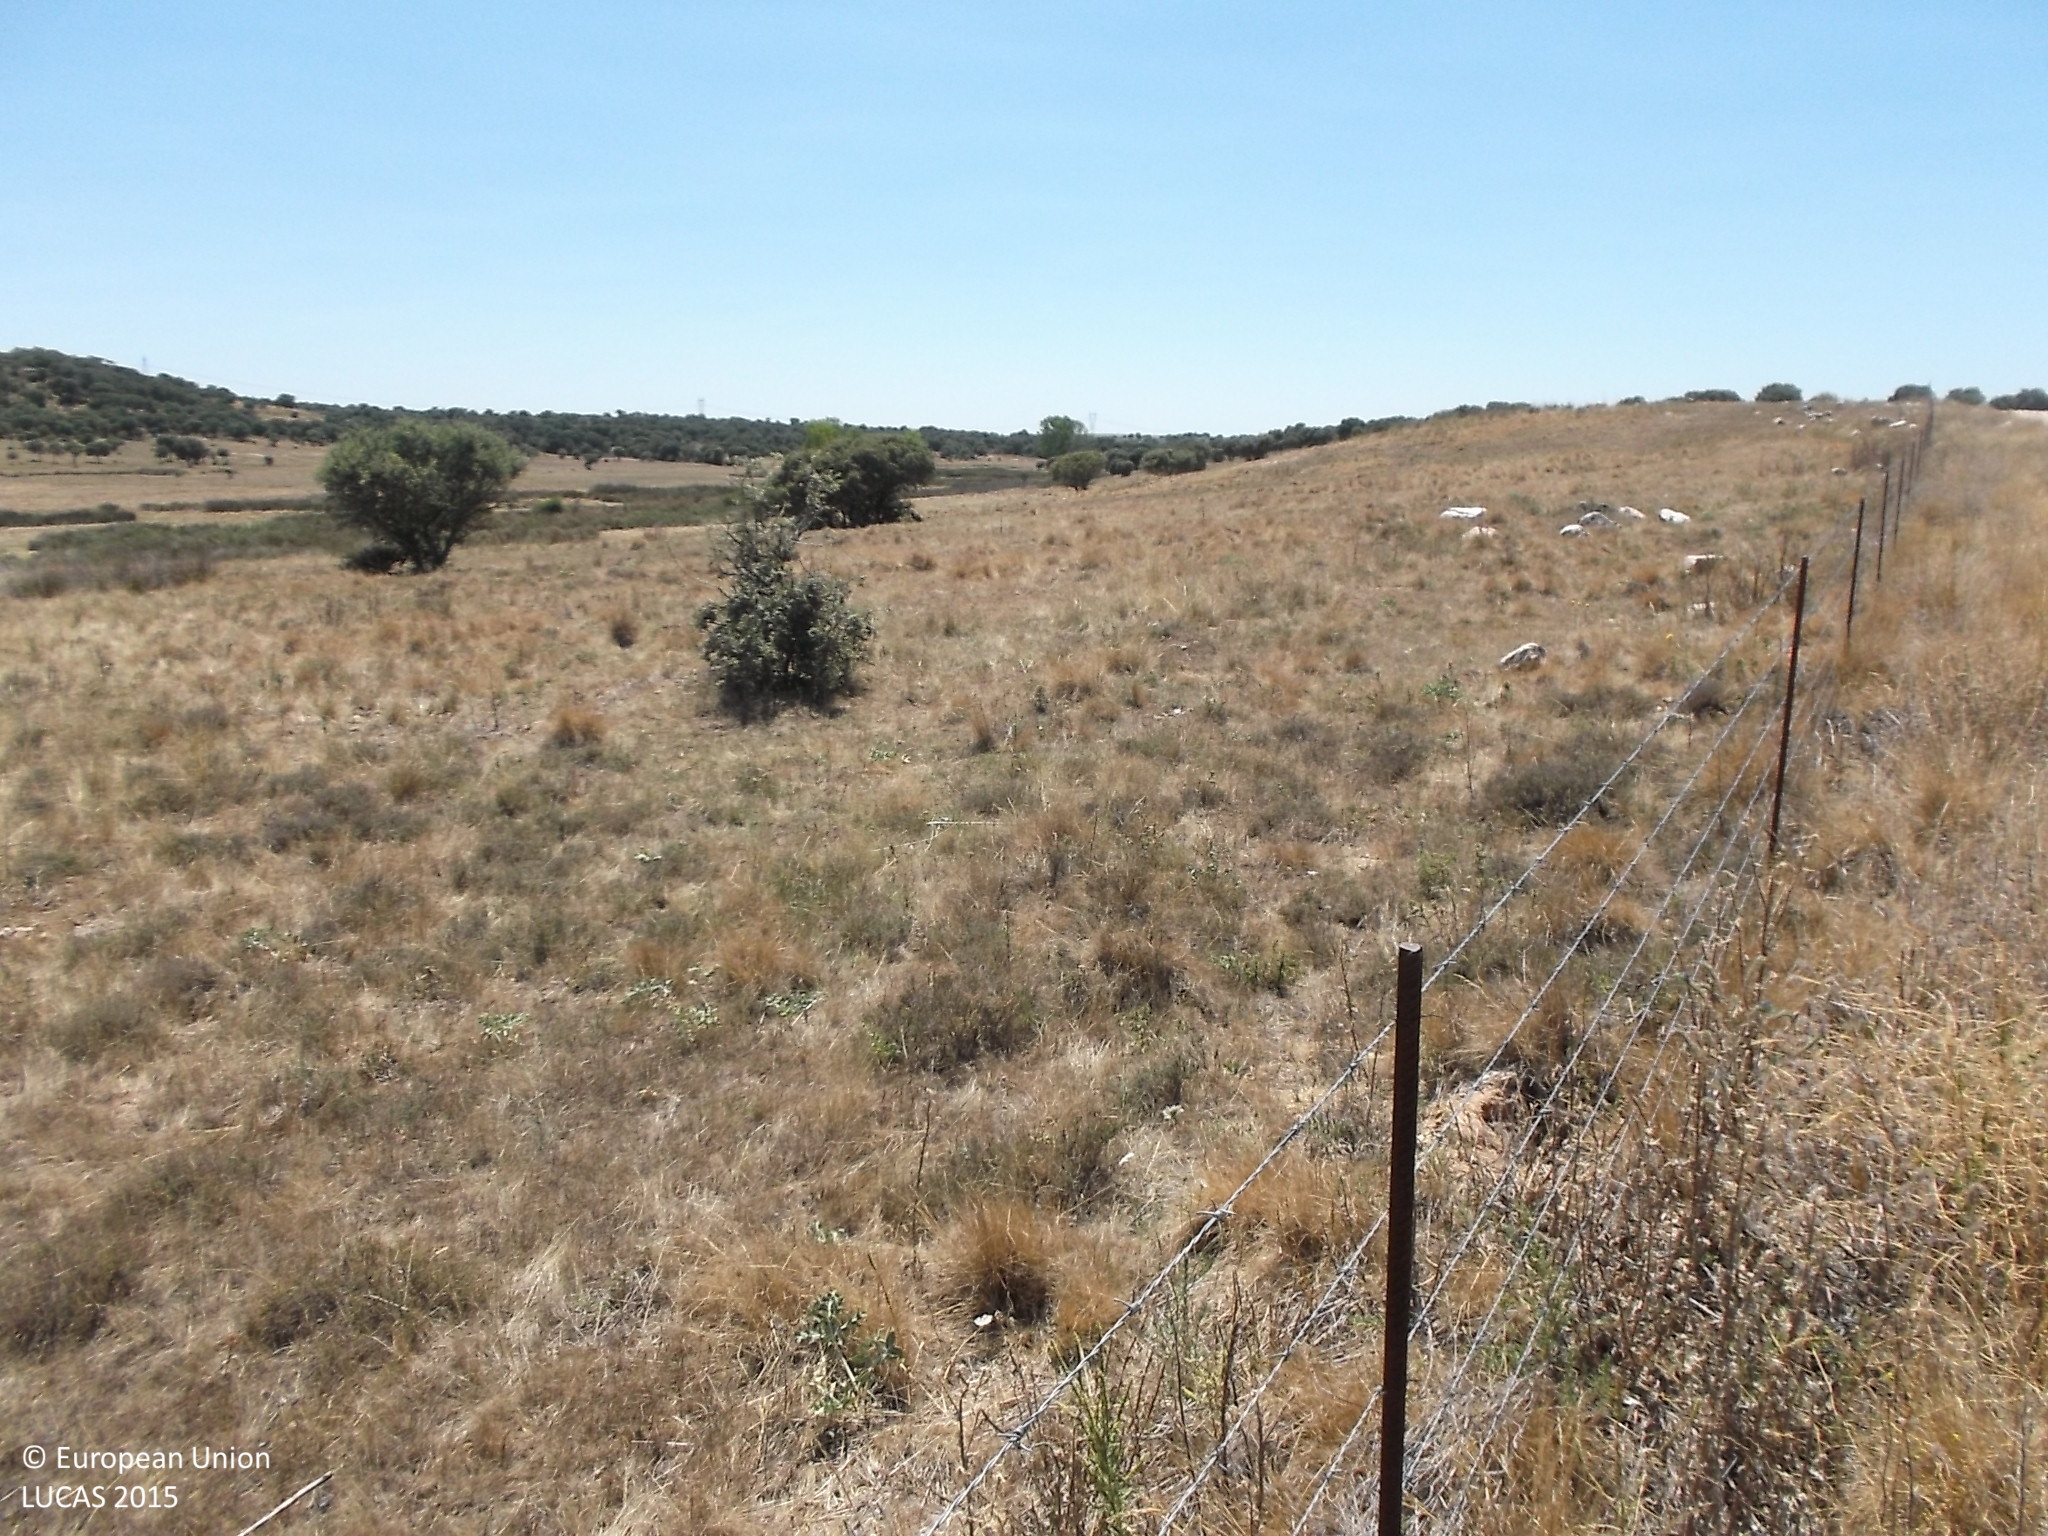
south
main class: Grassland
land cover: Grassland without tree/shrub cover
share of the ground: > 75 %
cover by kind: herbaceous plants 100 %
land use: Agriculture (excluding fallow land and kitchen gardens)
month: July
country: ES
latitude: 41.4022
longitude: -5.8159
